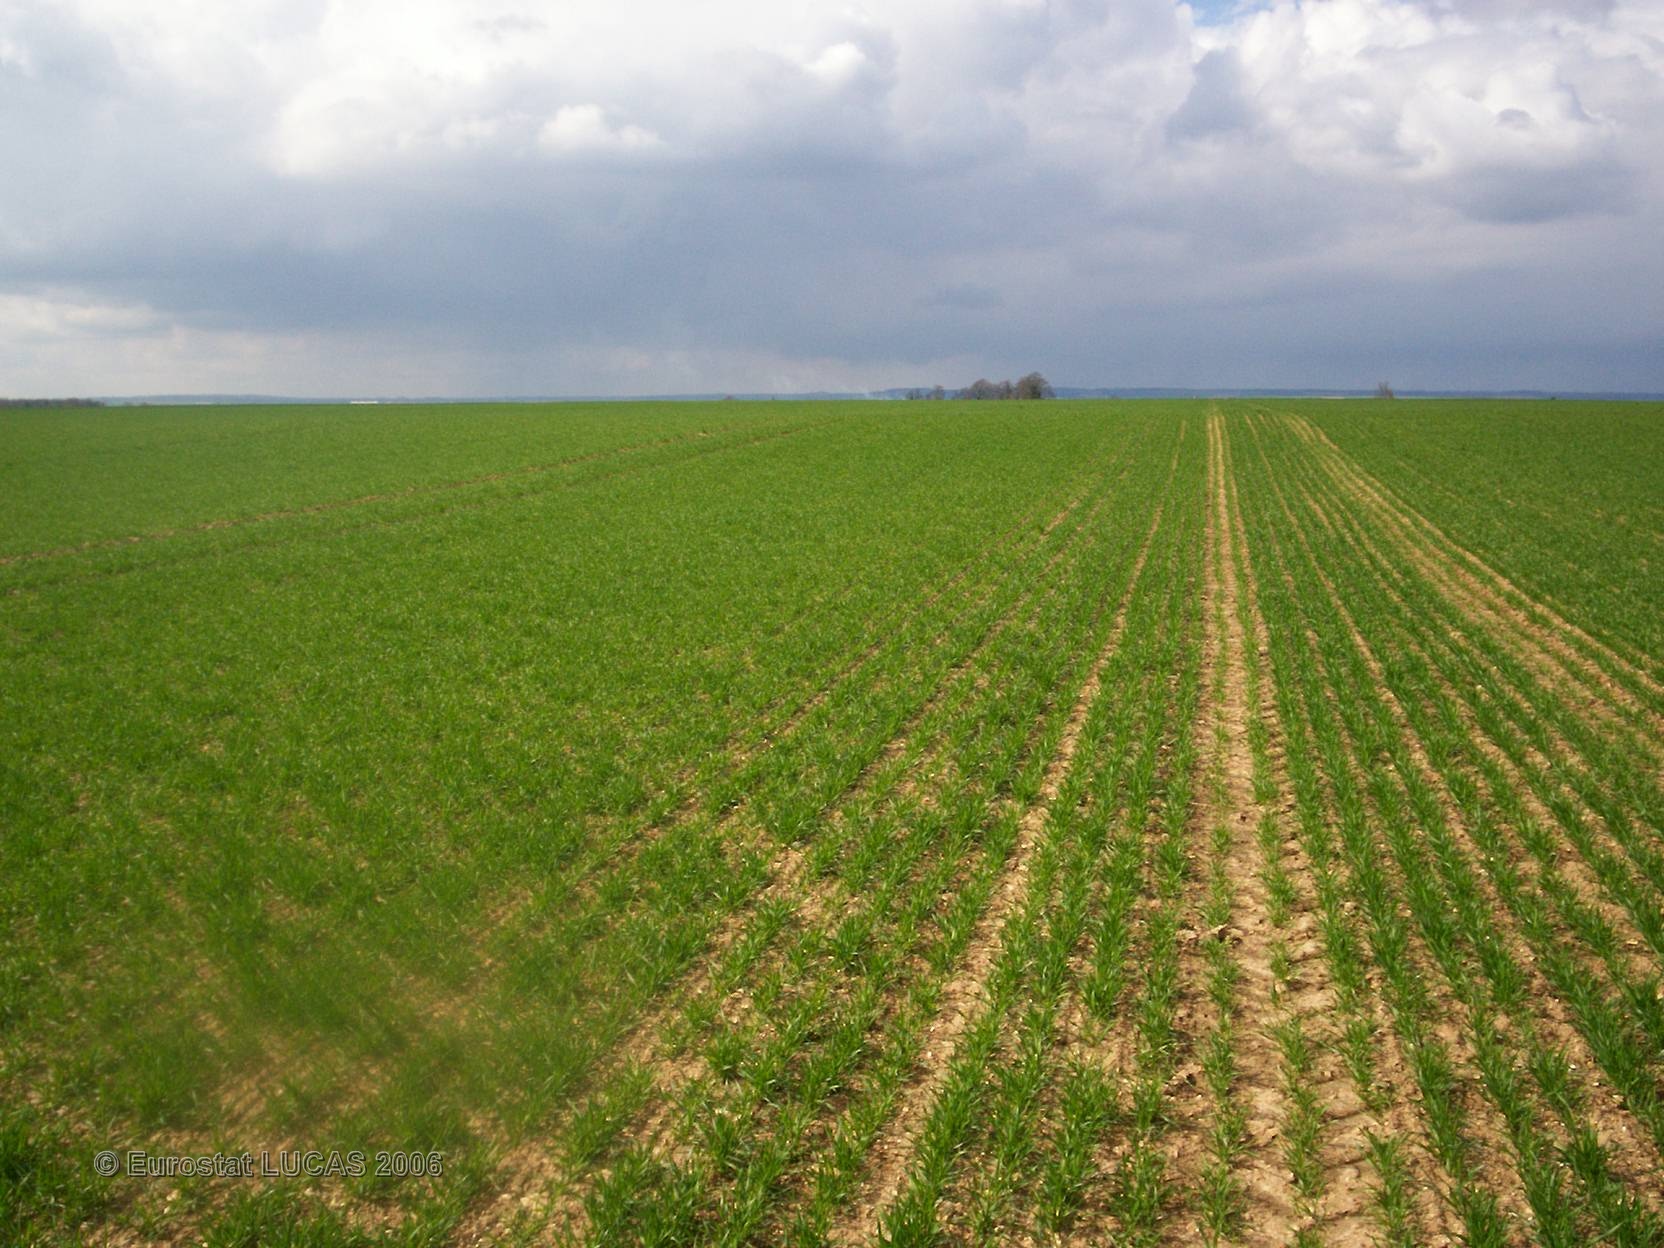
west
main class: Cropland
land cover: Common wheat
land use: Agriculture (excluding fallow land and kitchen gardens)
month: April
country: FR
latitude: 48.8689
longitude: -0.0513
